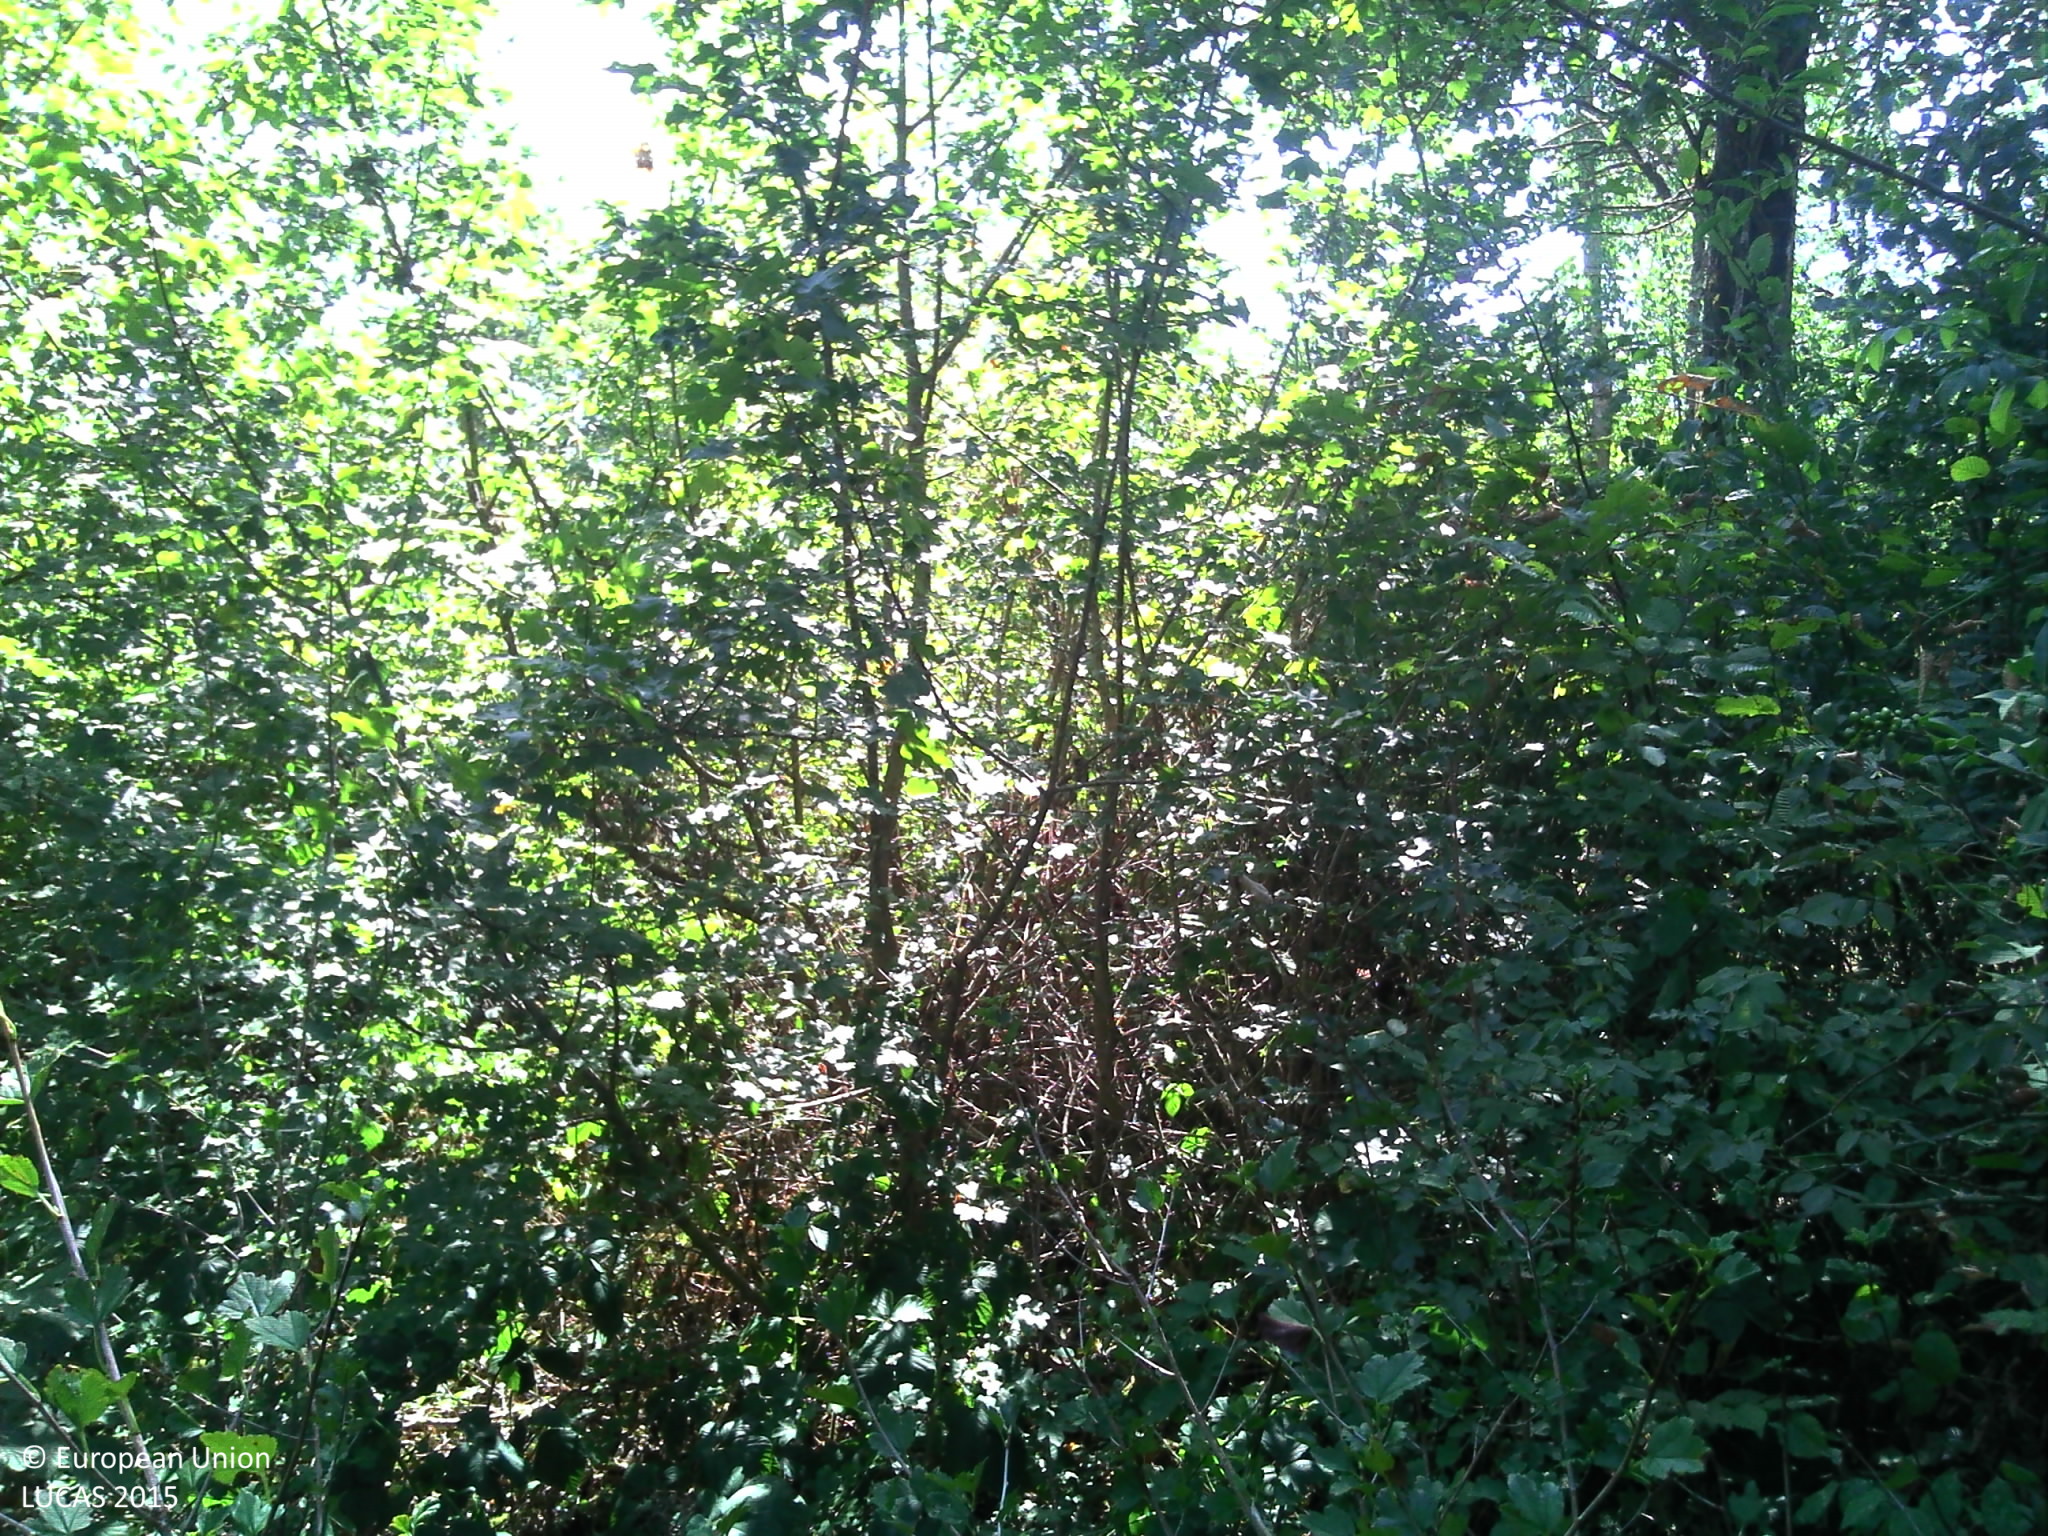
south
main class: Woodland
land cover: Broadleaved woodland
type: mesophytic deciduous forest
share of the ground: > 75 %
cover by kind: broadleaved forest trees 70 %, shrubs 20 %, herbaceous plants 10 %
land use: Forestry
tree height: > 5 m
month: August
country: FR
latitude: 47.2177
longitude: 4.8108
